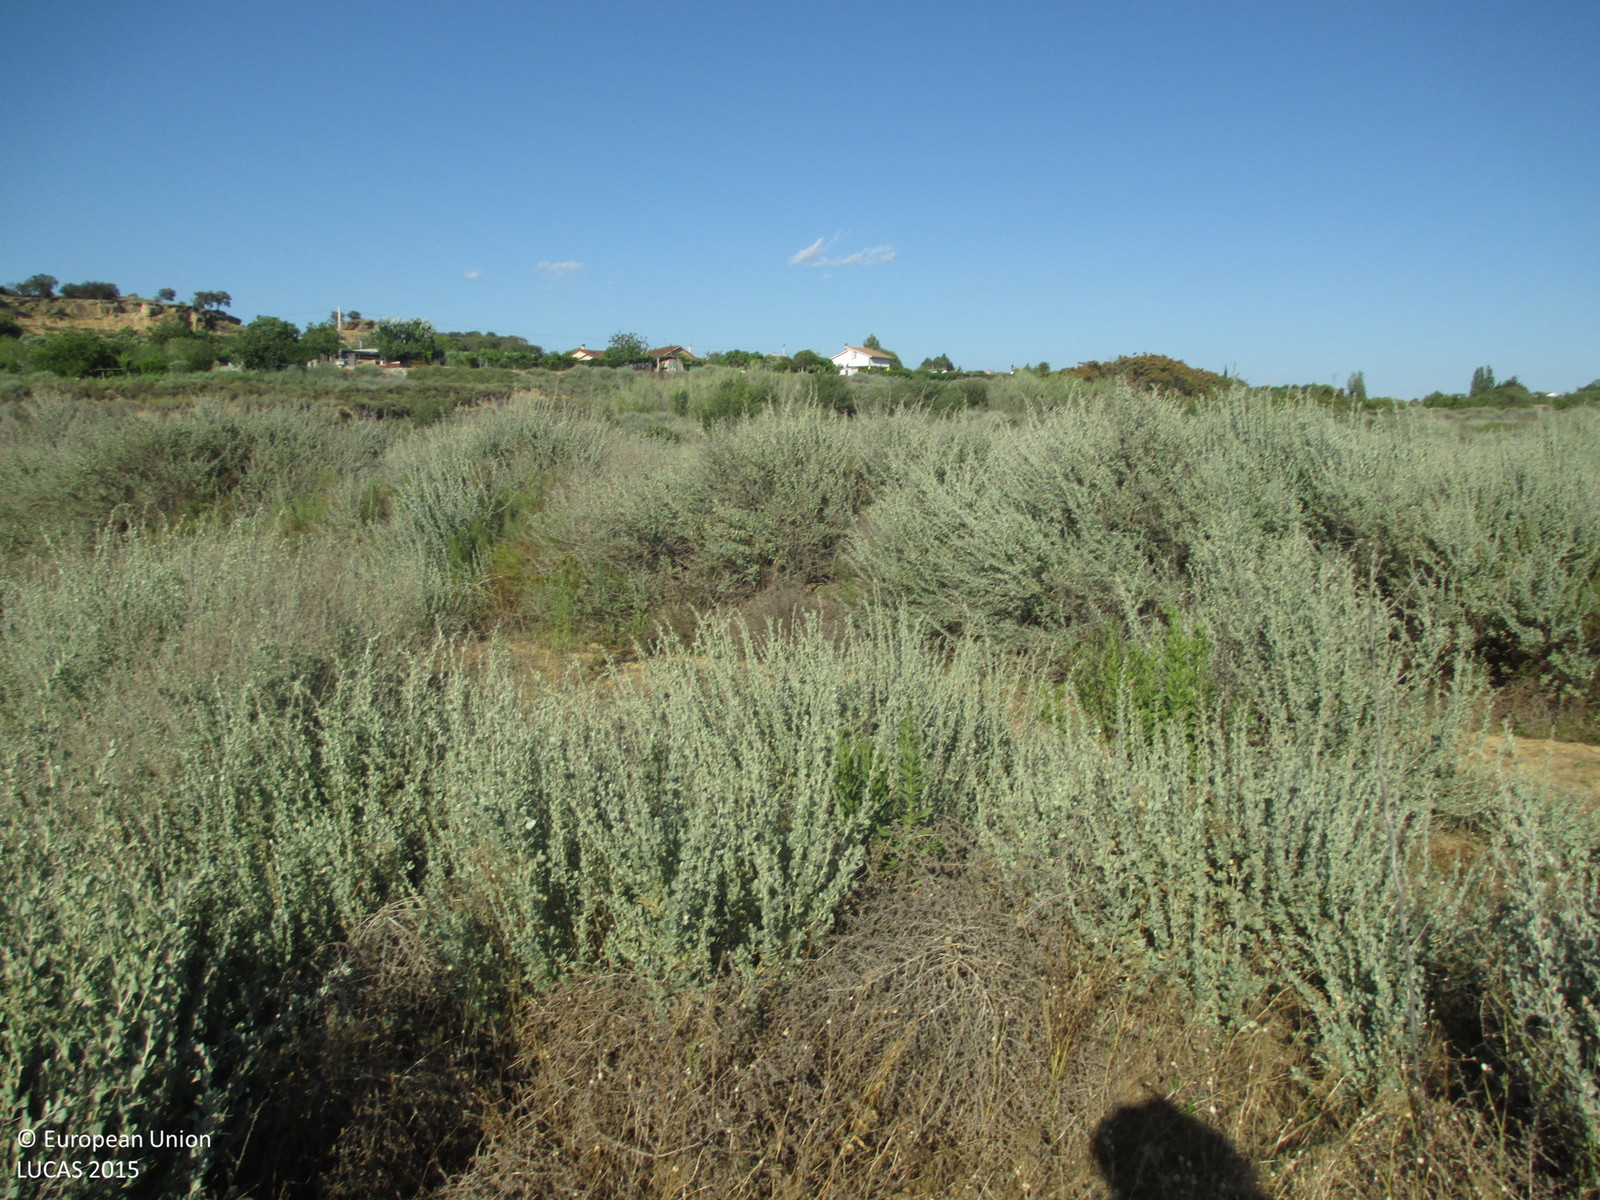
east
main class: Shrubland
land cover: Shrubland without tree cover
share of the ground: > 75 %
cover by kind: shrubs 100 %
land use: Abandoned areas
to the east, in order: Shrubland without tree cover; Rivers and streams; Broadleaved woodland; Rivers and streams; Broadleaved woodland; Shruby margins; Spontaneously vegetated surfaces; Shrubland without tree cover; Electric lines; Ditches and canals; Railways; Ditches and canals; Shrubland without tree cover
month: June
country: ES
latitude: 41.9056
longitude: 0.2066
